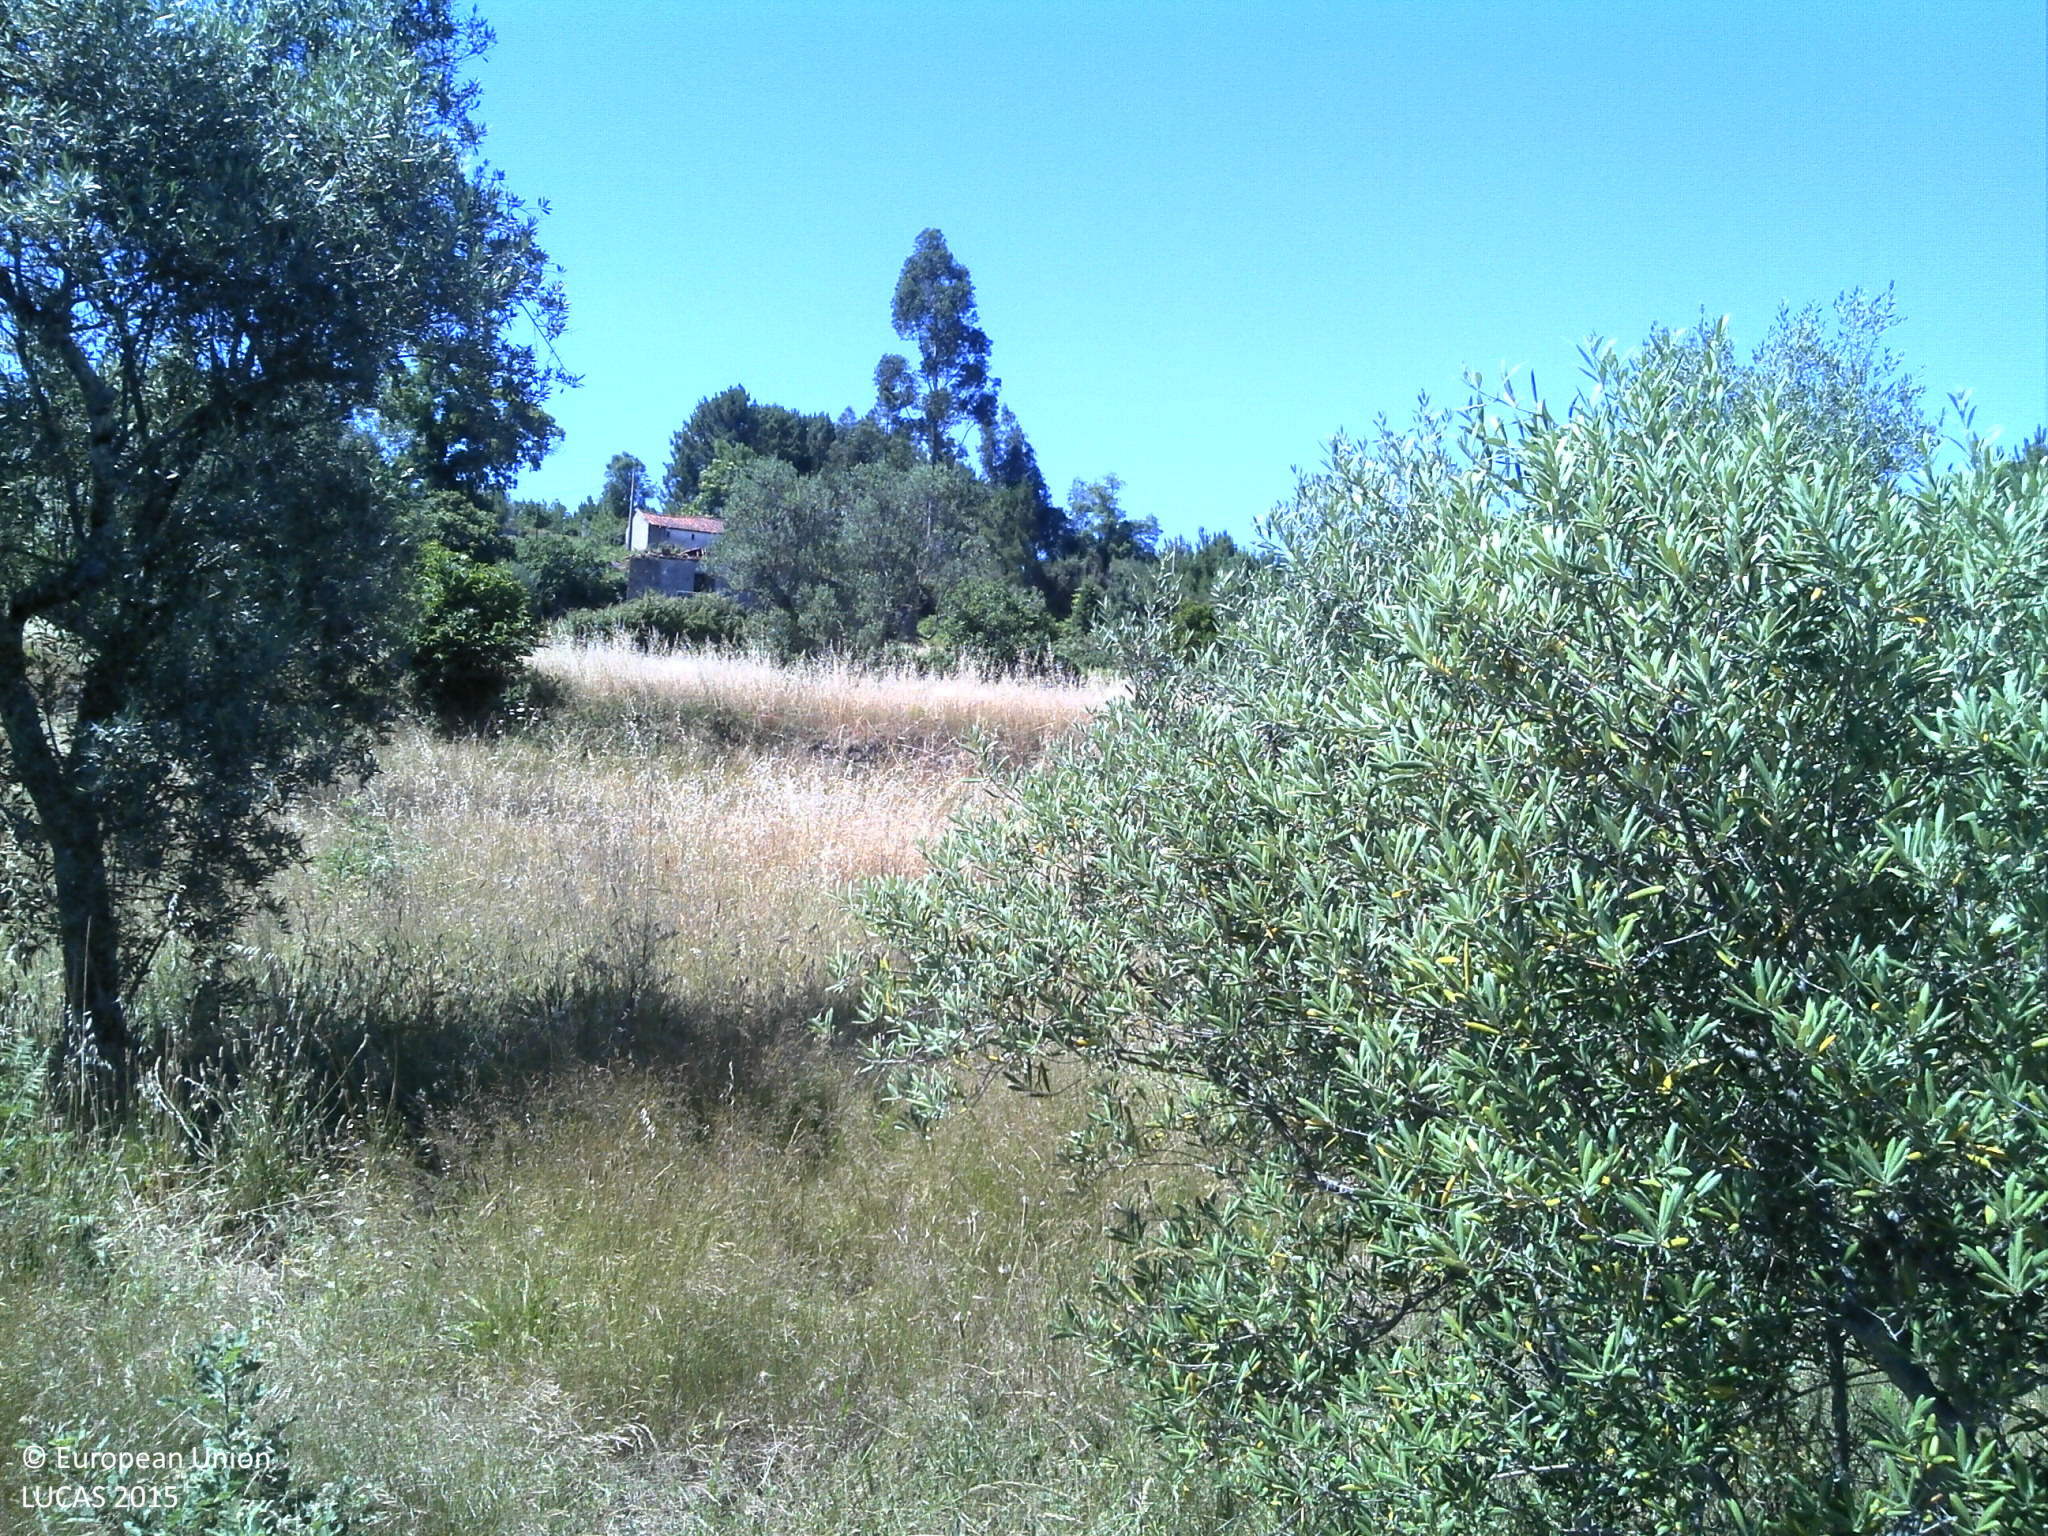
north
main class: Cropland
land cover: Olive groves
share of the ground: 10 - 25 %
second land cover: Grassland without tree/shrub cover
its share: > 75 %
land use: Agriculture (excluding fallow land and kitchen gardens)
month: June
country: PT
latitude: 40.6690
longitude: -7.8312
